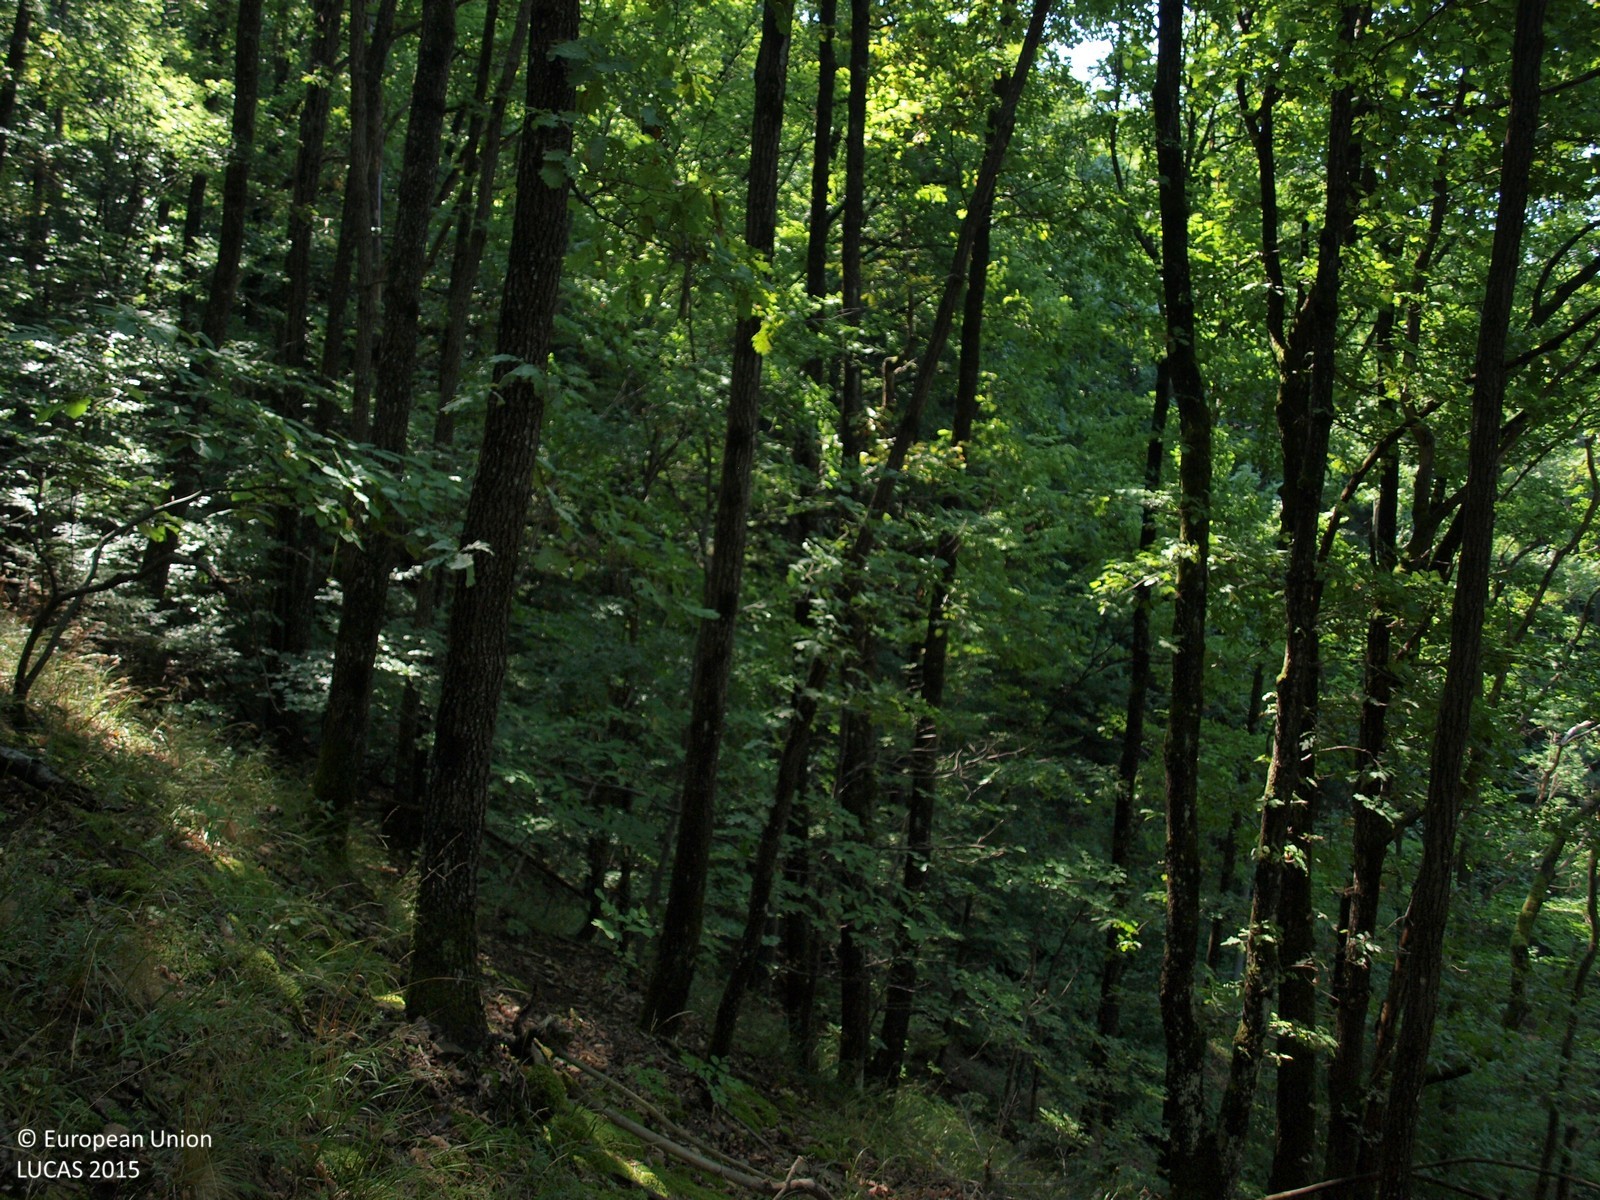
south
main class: Woodland
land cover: Broadleaved woodland
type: mesophytic deciduous forest
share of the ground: > 75 %
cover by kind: broadleaved forest trees 100 %
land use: Forestry
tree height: > 5 m
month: July
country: HR
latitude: 45.9166
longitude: 15.9160
